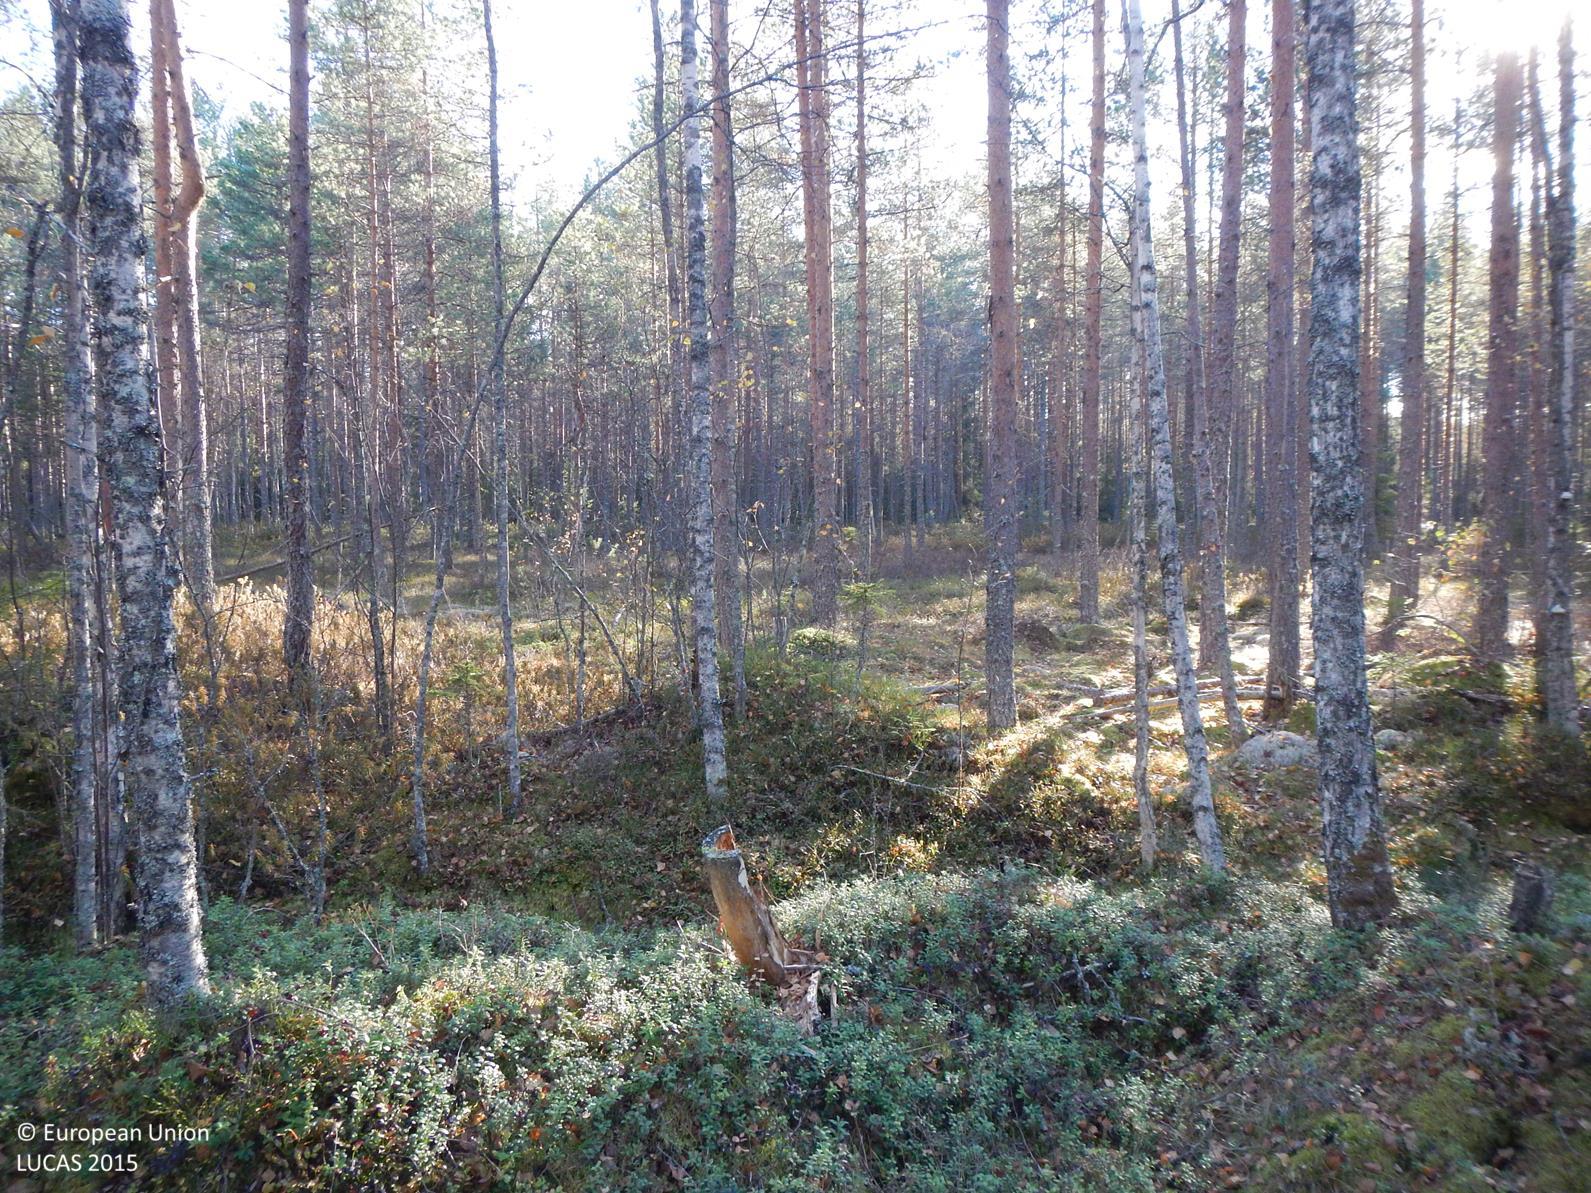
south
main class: Woodland
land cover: Pine dominated coniferous woodland
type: mire and swamp forests
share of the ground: 50 - 75 %
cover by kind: coniferous forest trees 60 %, shrubs 20 %, lichens and mosses 20 %
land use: Forestry
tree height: > 5 m
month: October
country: FI
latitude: 61.8844
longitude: 25.9357
